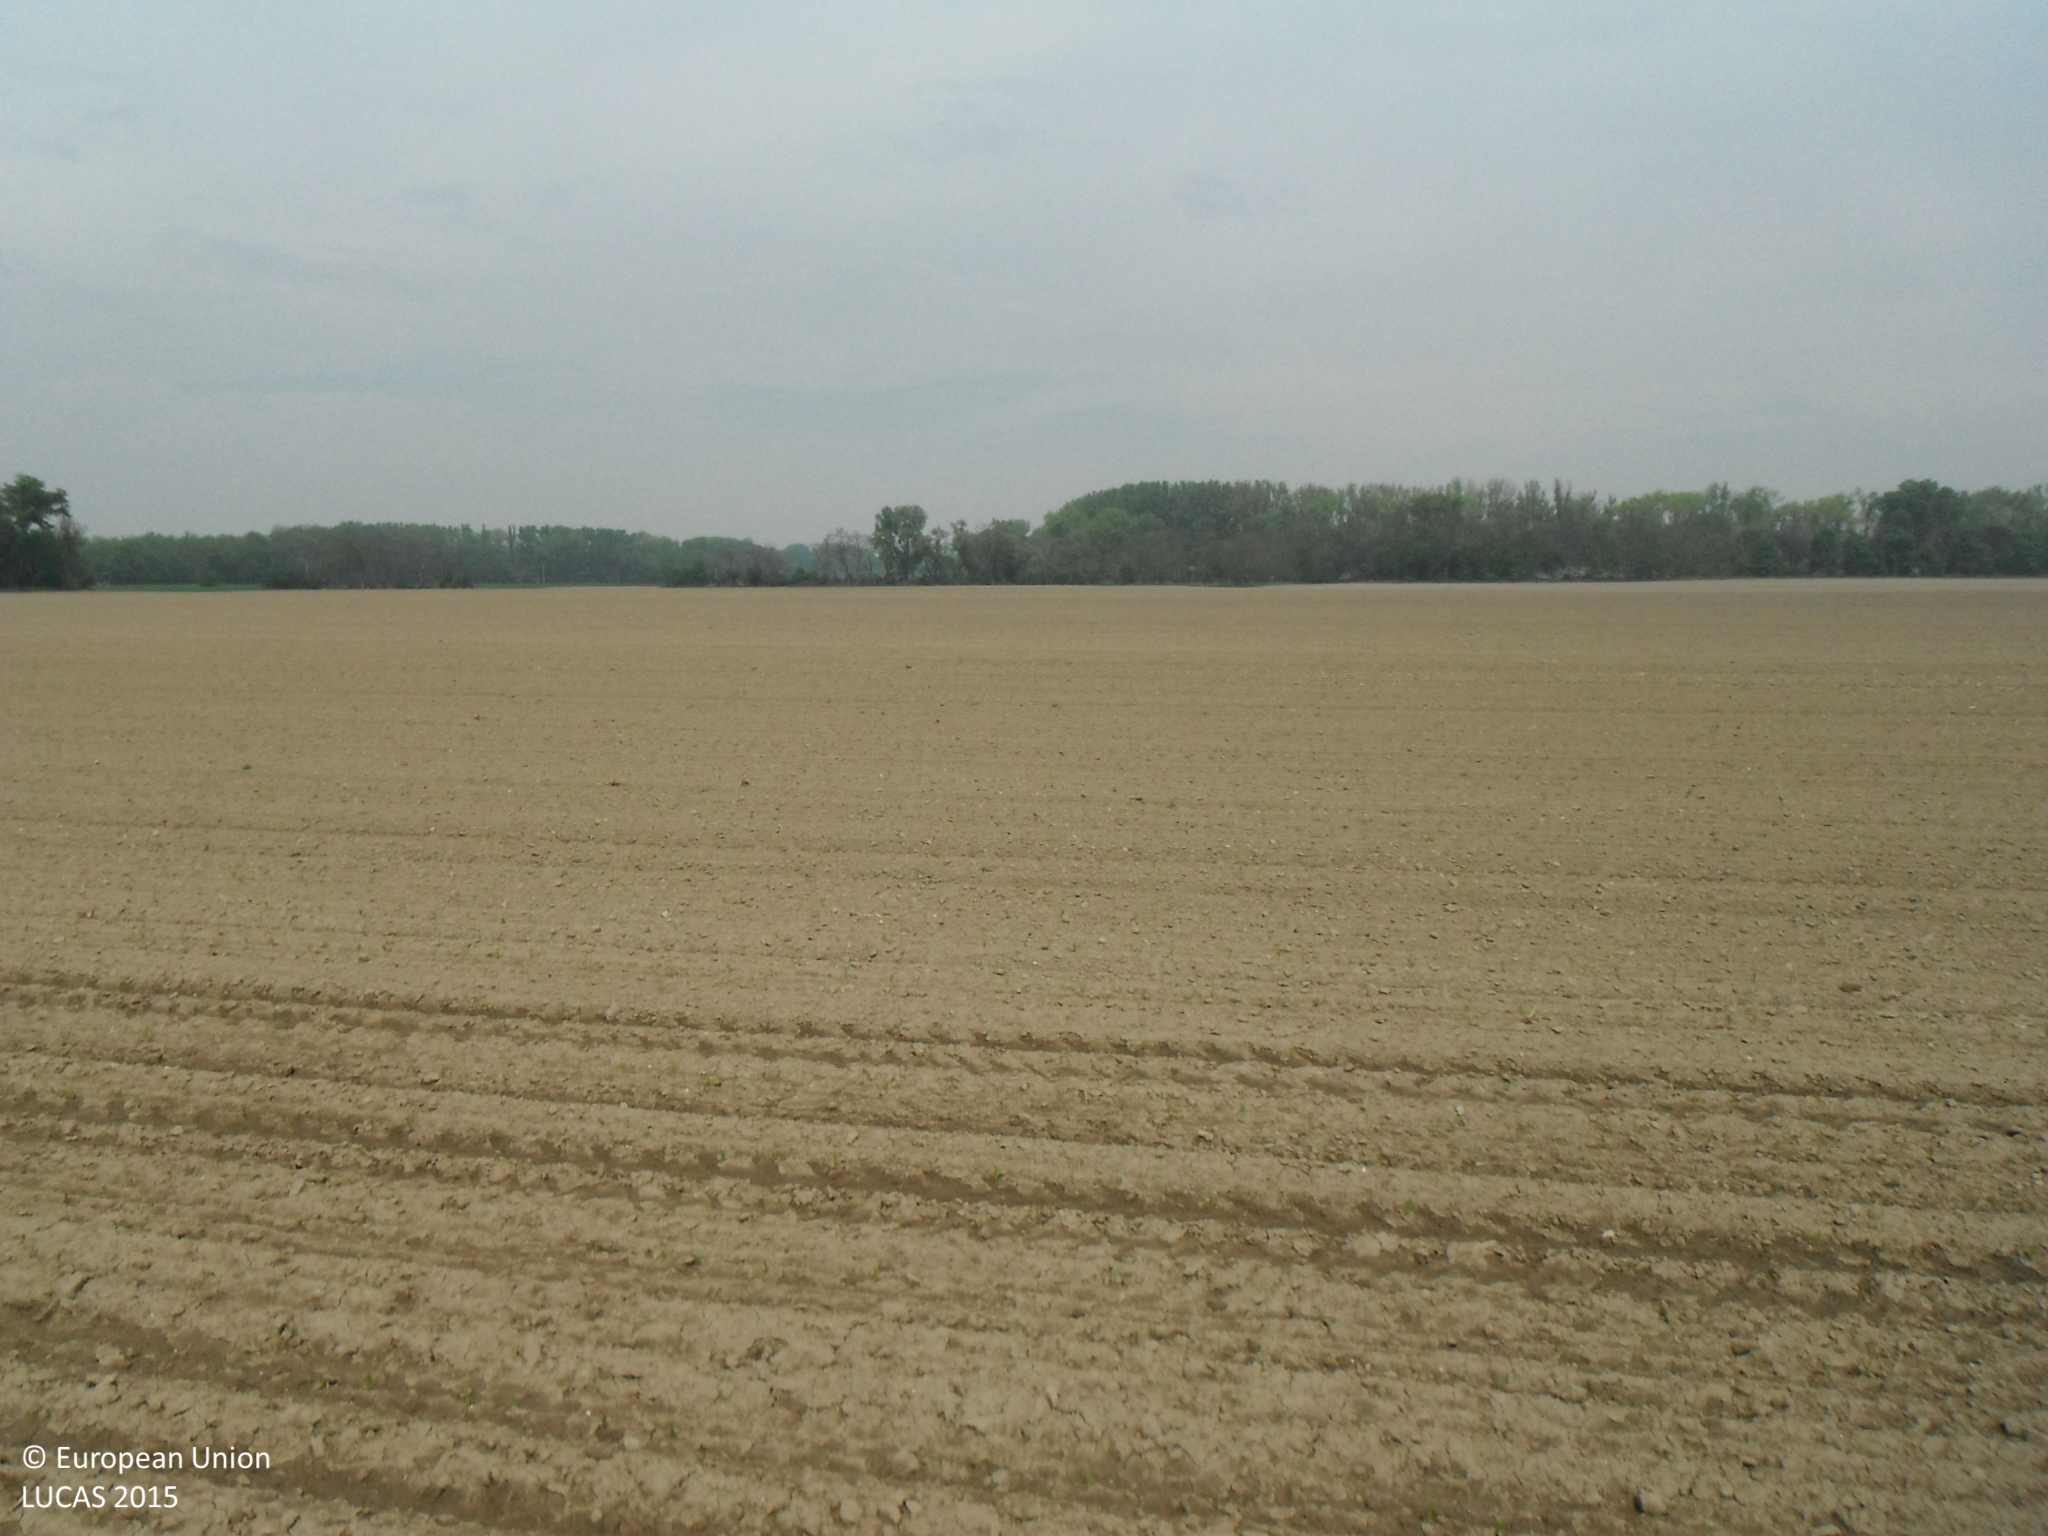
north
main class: Cropland
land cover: Other fresh vegetables
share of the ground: < 10 %
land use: Agriculture (excluding fallow land and kitchen gardens)
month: May
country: SK
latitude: 48.1561
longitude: 17.3896
